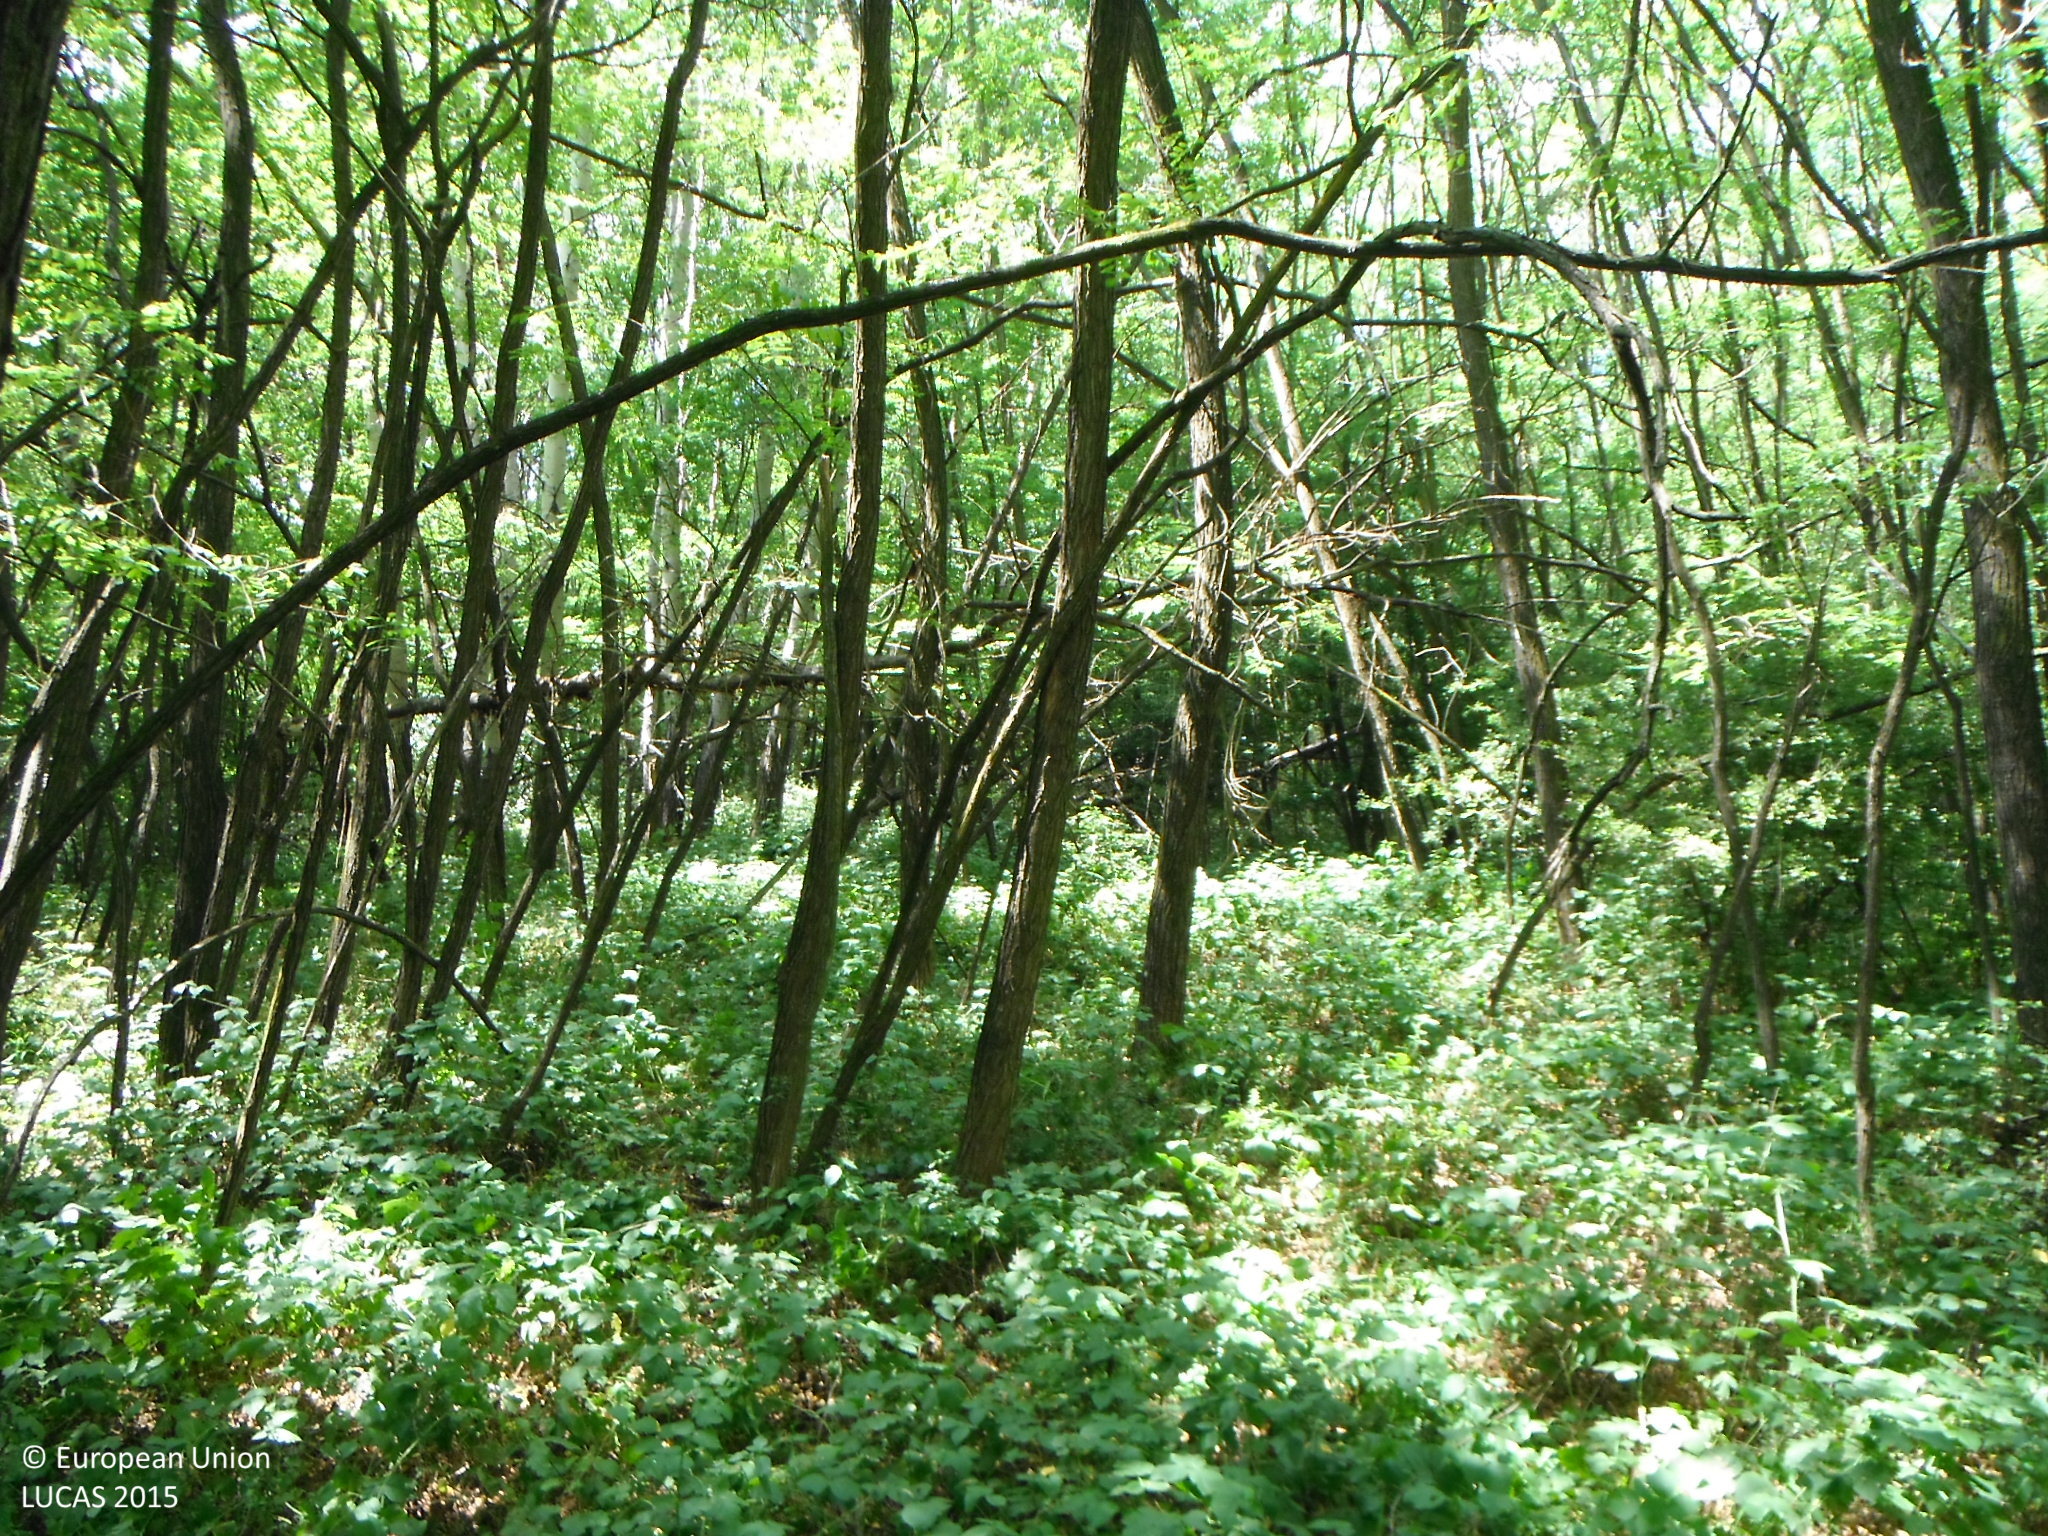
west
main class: Woodland
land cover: Broadleaved woodland
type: mesophytic deciduous forest
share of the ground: > 75 %
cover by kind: broadleaved forest trees 100 %
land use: Forestry
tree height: > 5 m
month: July
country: SK
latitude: 48.2596
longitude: 19.1404
